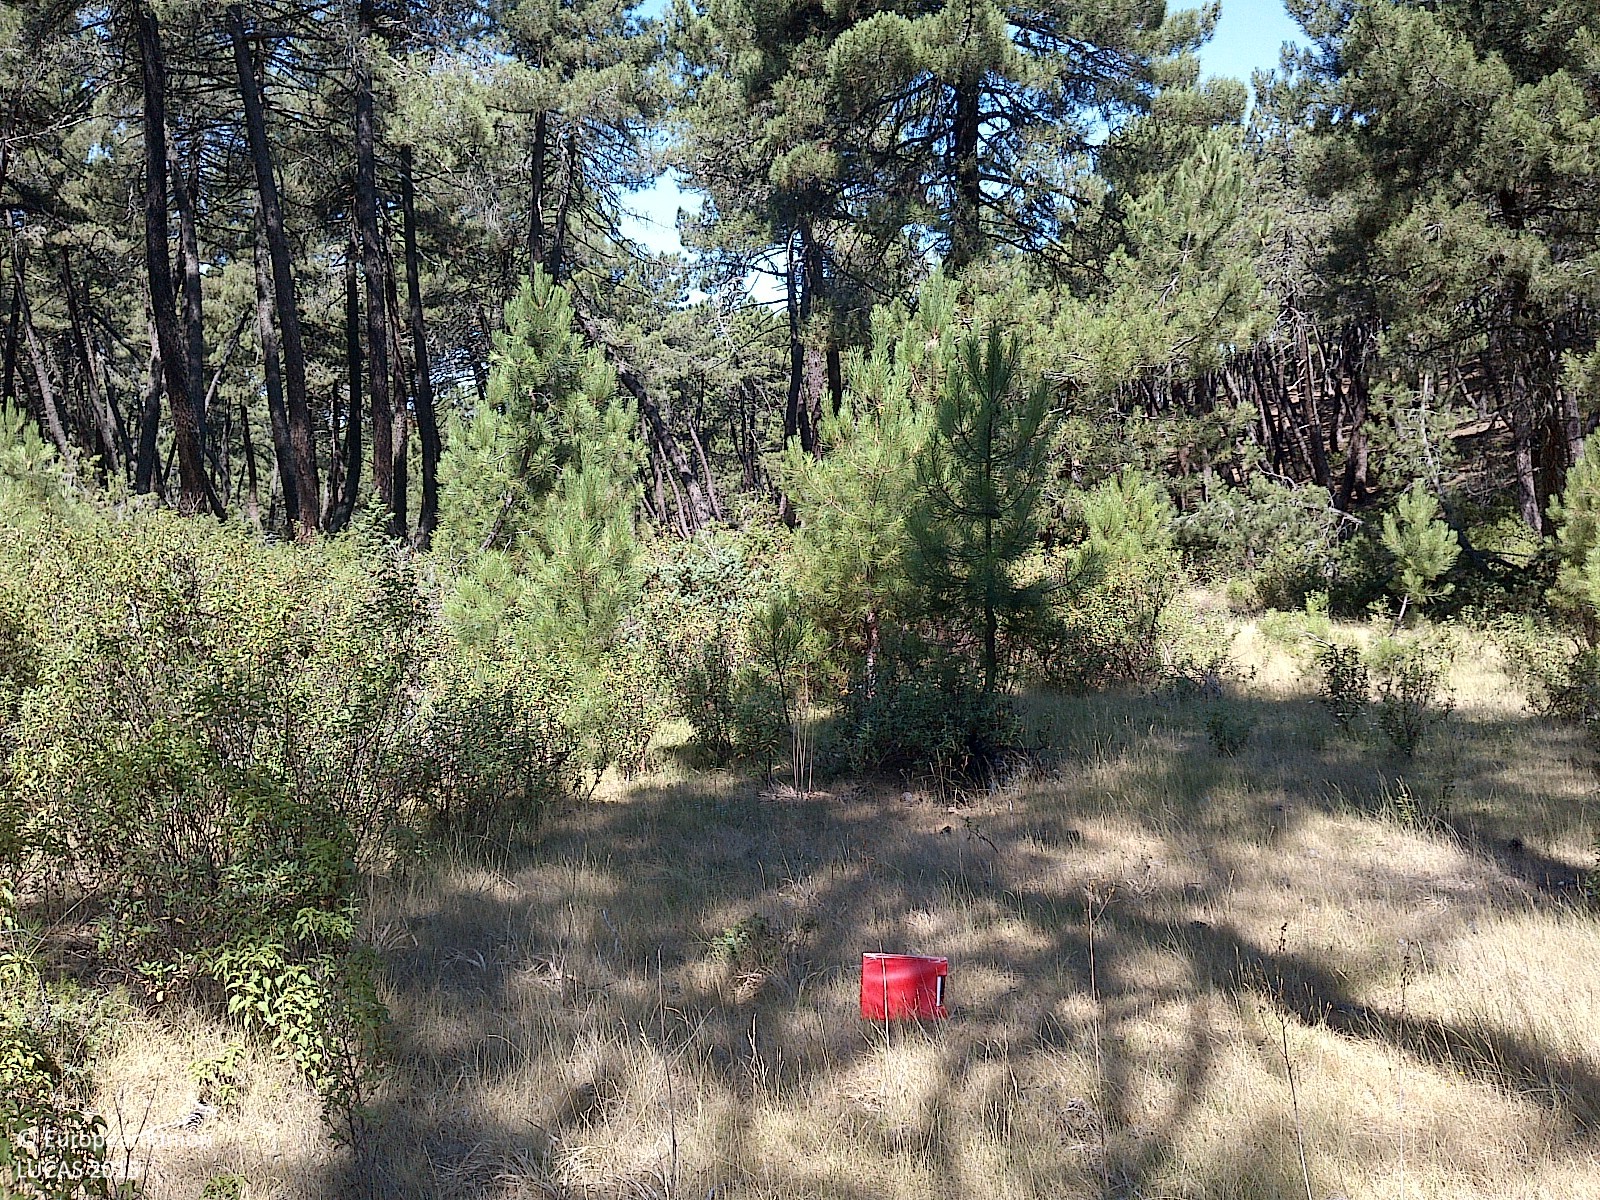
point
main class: Woodland
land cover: Pine dominated coniferous woodland
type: coniferous forest of the mediterranean region
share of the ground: 25 - 50 %
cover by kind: coniferous forest trees 40 %, shrubs 30 %, herbaceous plants 30 %
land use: Forestry
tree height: > 5 m
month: July
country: ES
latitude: 41.7892
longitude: -3.1752
